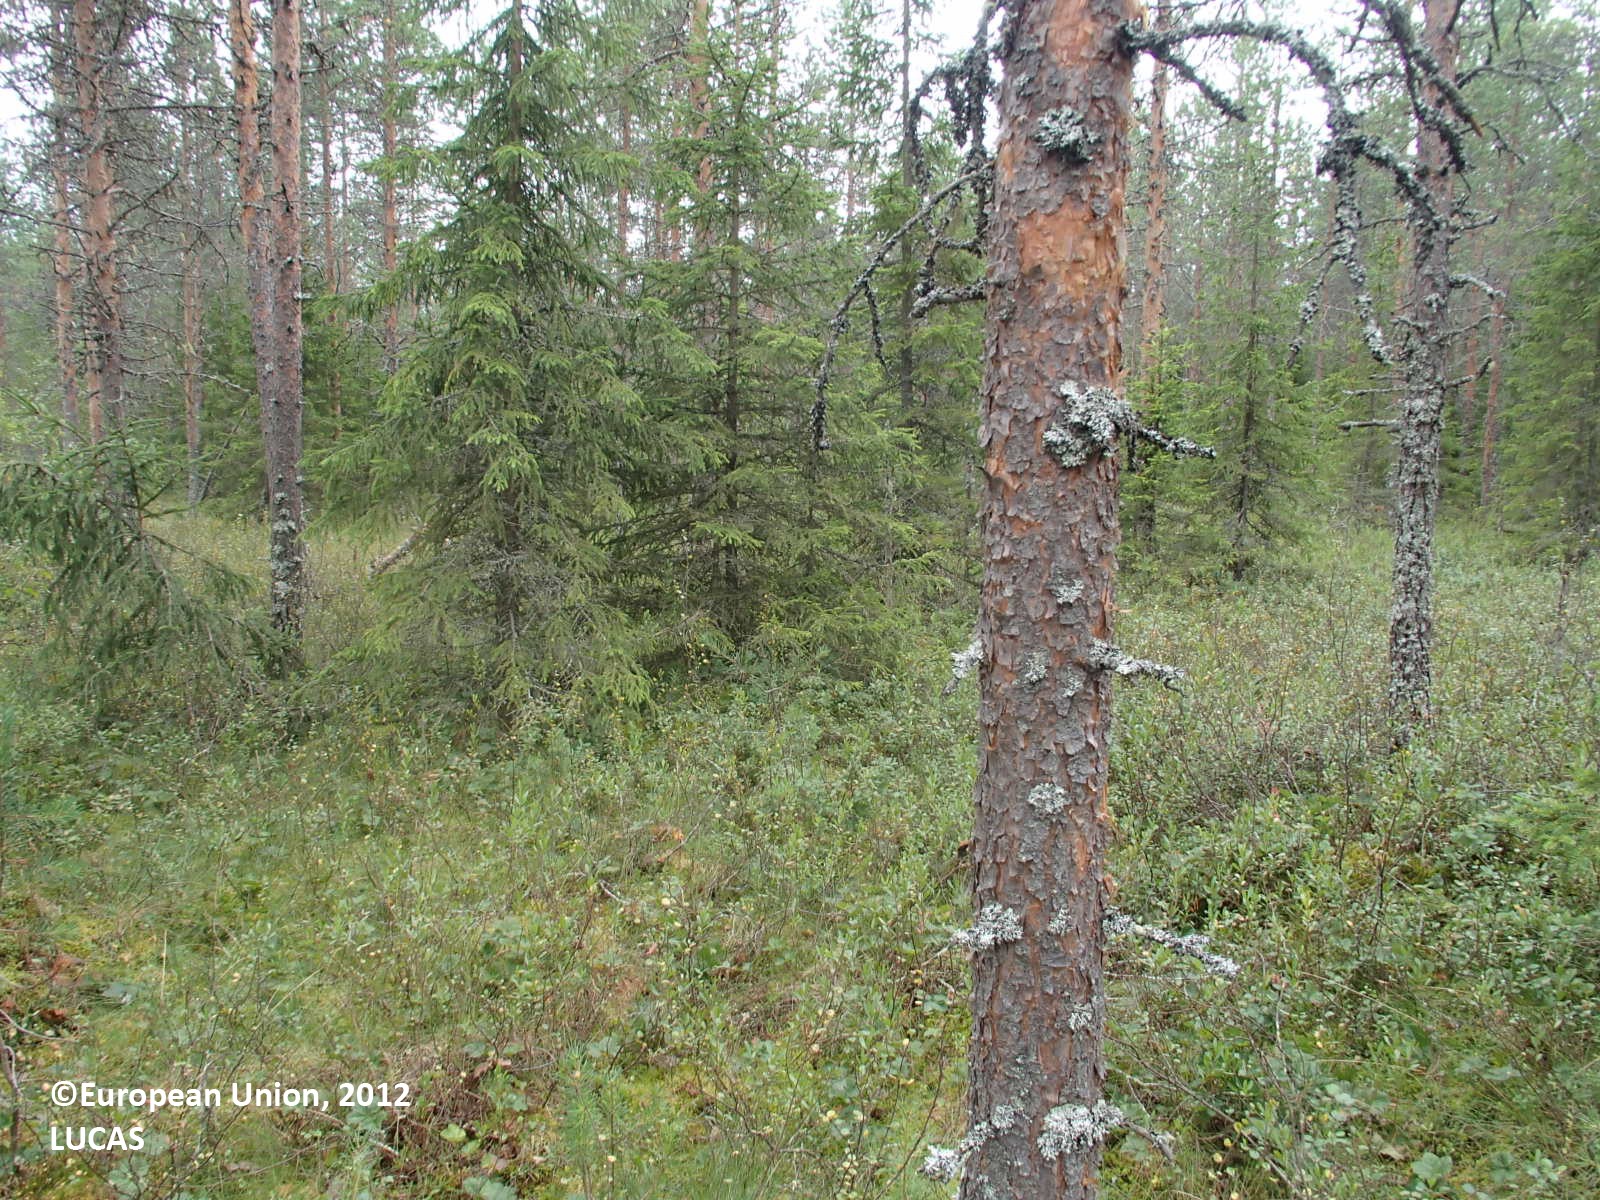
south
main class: Woodland
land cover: Other coniferous woodland
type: boreal forest
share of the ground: > 75 %
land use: Forestry
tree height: > 5 m
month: August
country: FI
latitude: 63.6314
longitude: 27.8642
